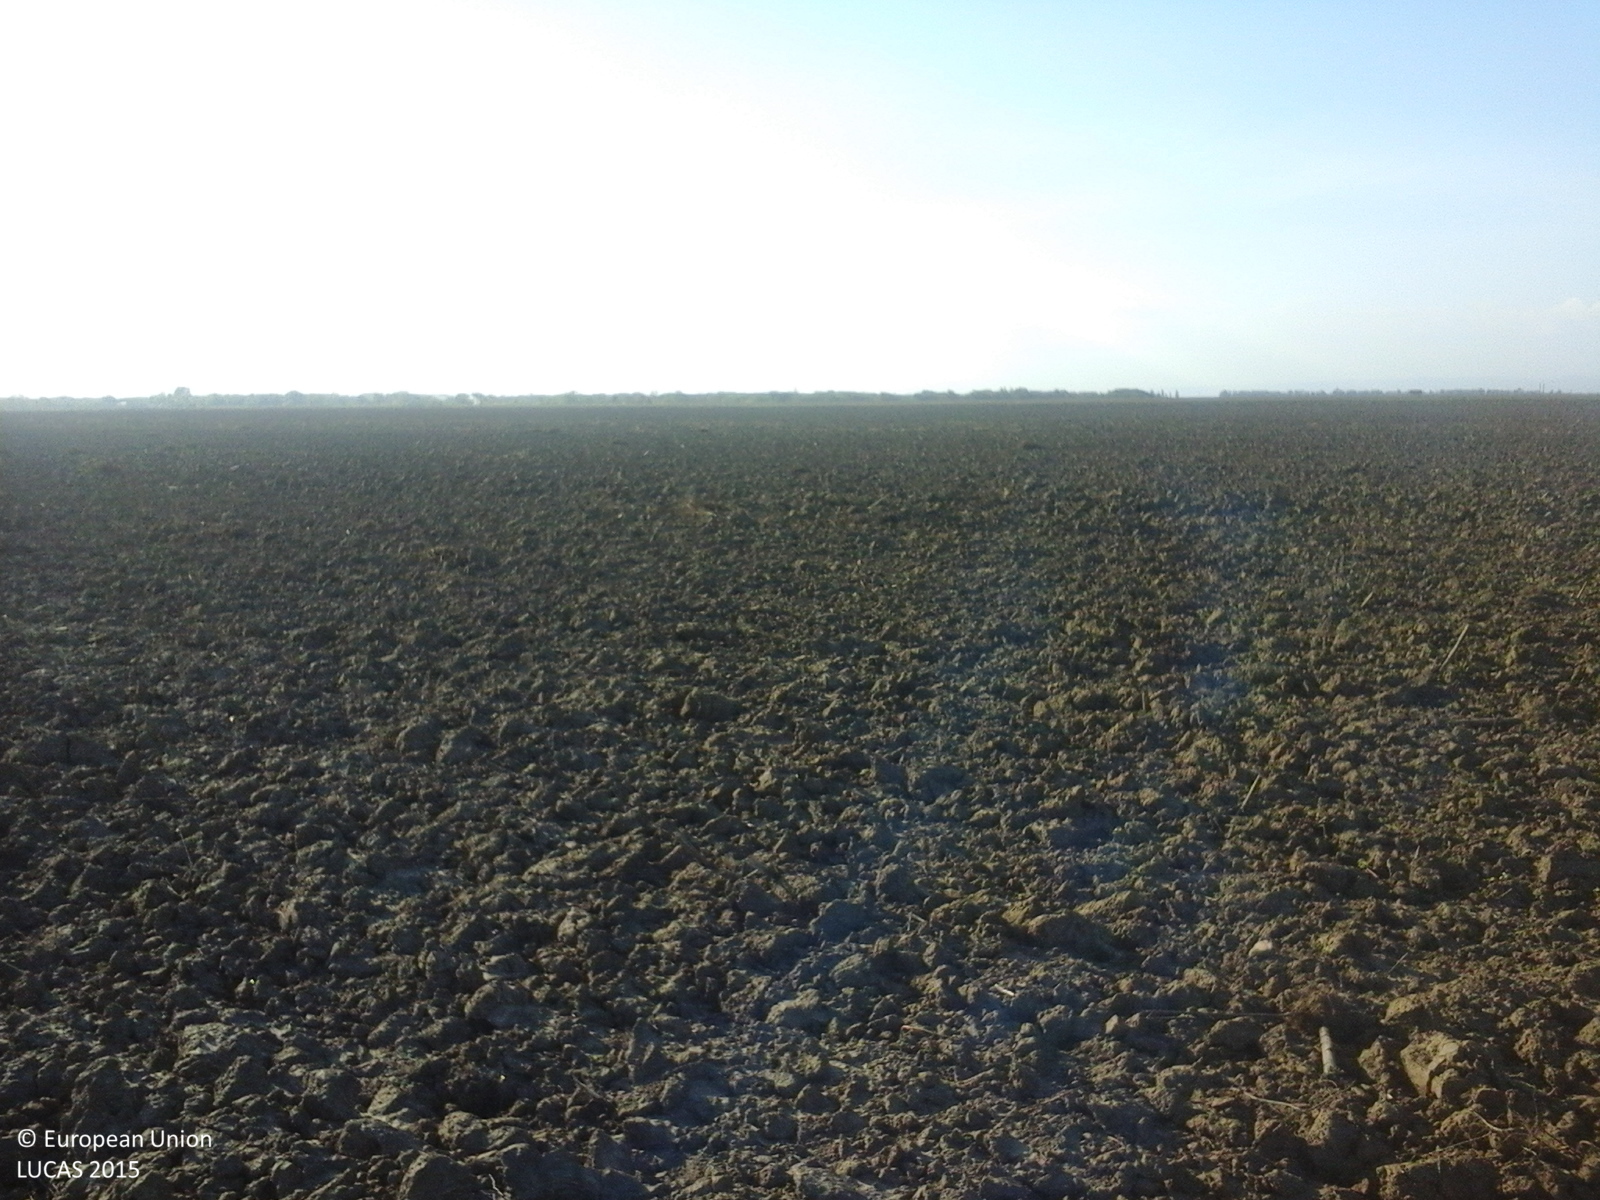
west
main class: Cropland
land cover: Sunflower
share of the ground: < 10 %
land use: Agriculture (excluding fallow land and kitchen gardens)
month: October
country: RO
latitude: 45.2572
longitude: 27.3104
